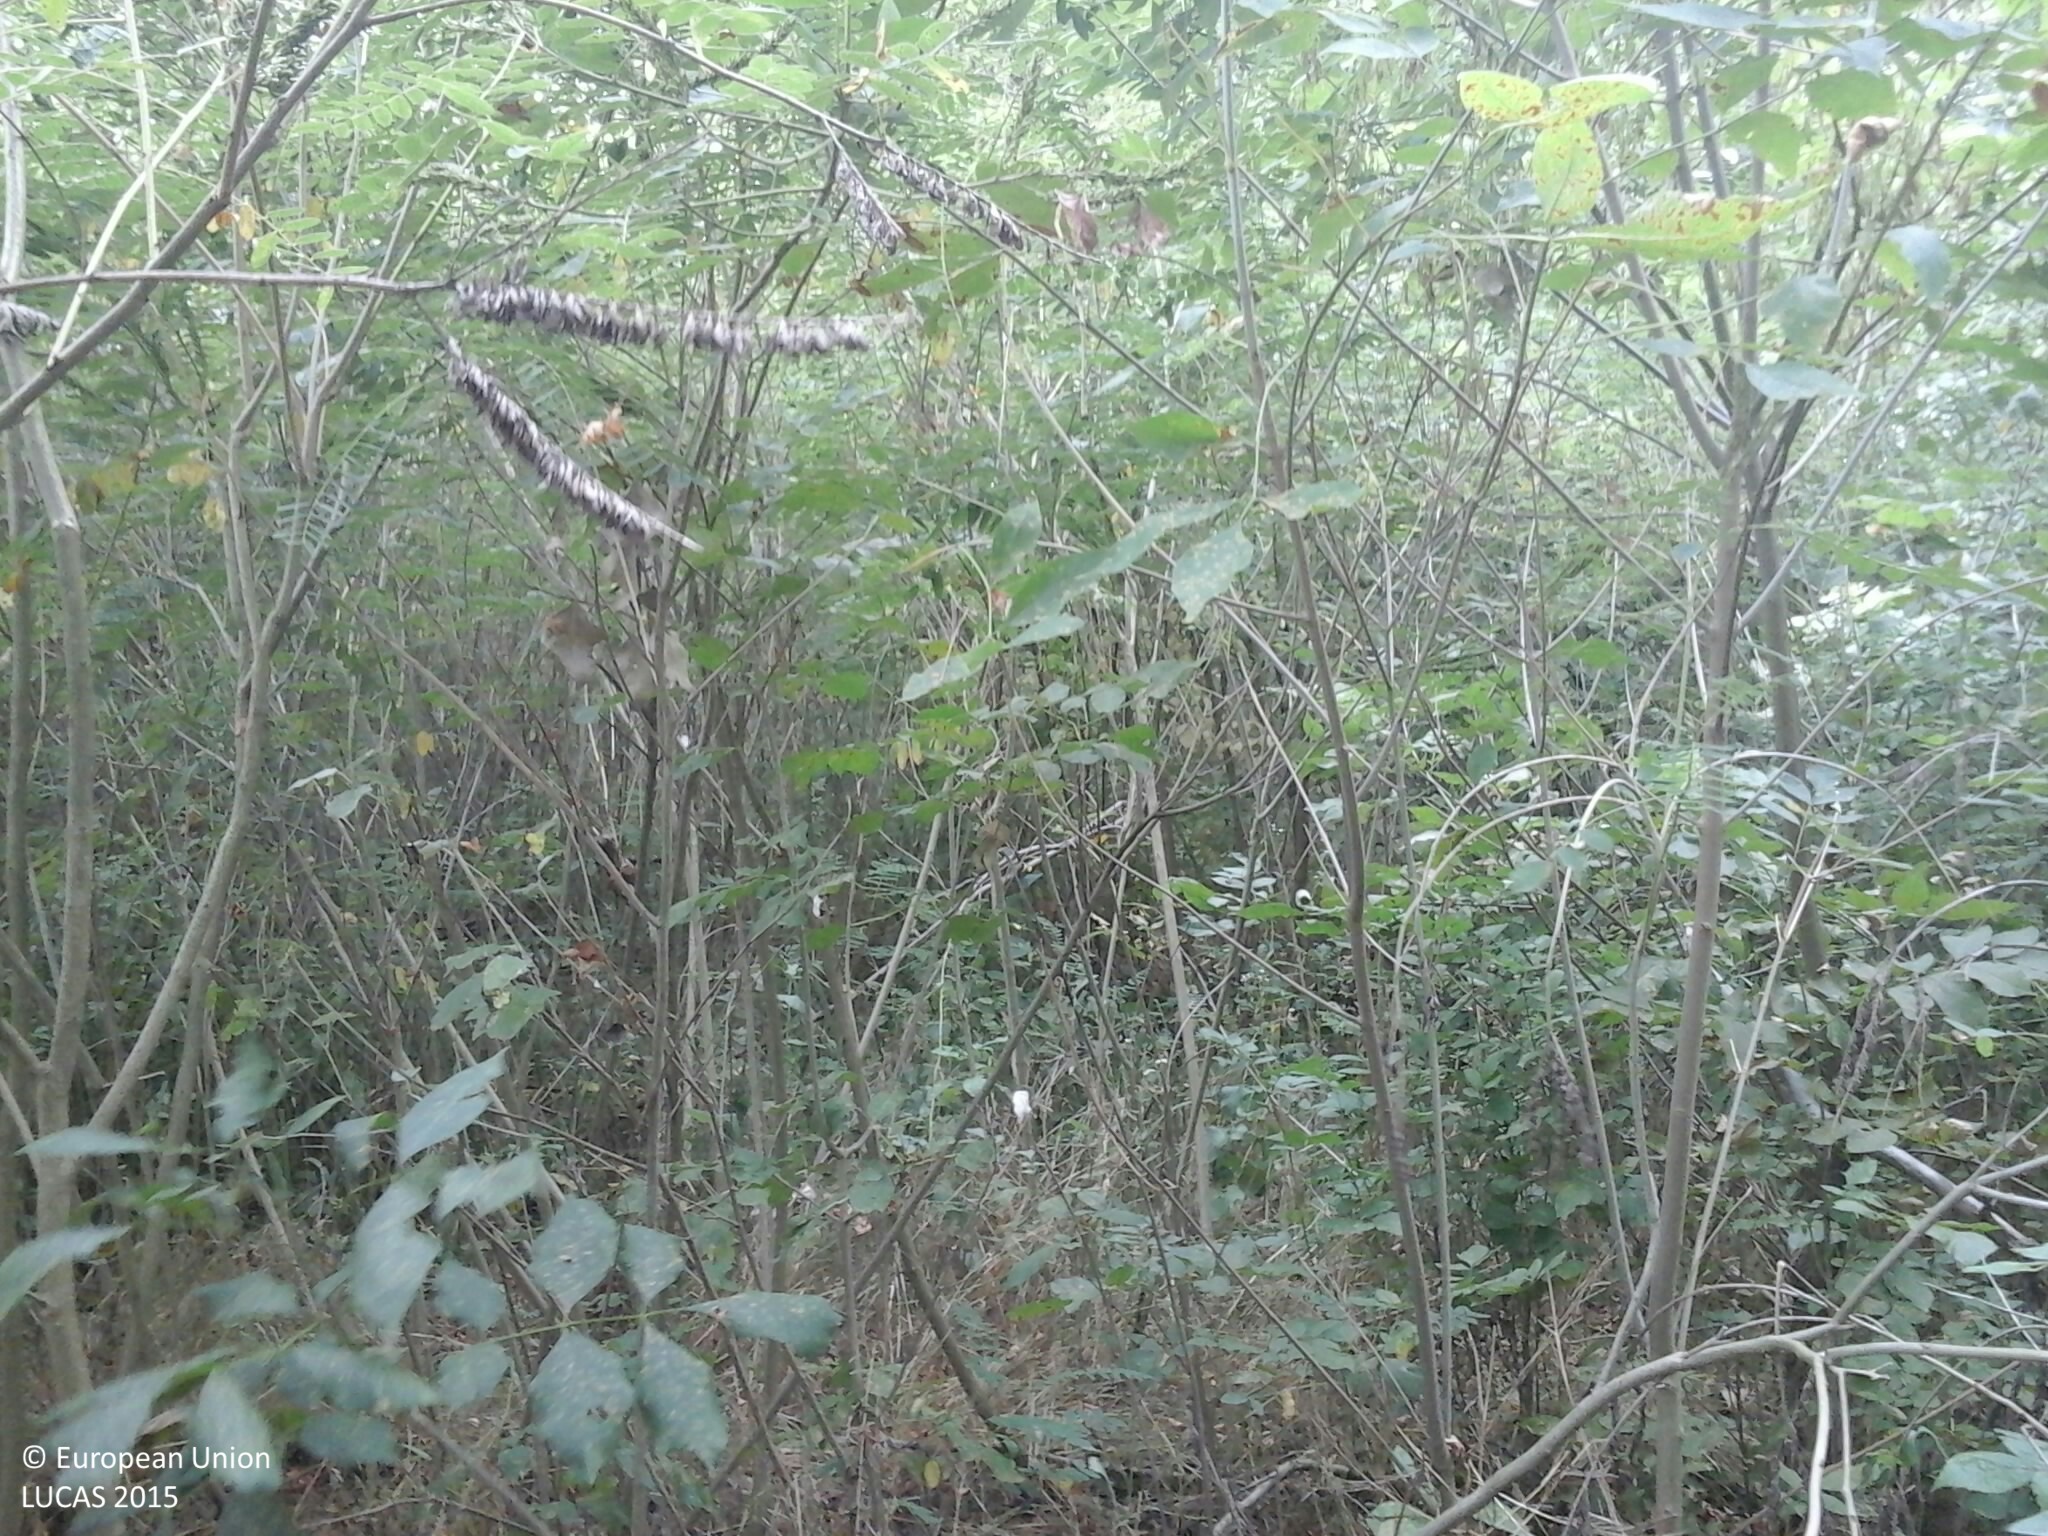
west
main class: Woodland
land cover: Broadleaved woodland
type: floodplain forest
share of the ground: > 75 %
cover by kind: broadleaved forest trees 90 %, shrubs 5 %, herbaceous plants 5 %
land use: Forestry
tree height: < 5 m
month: July
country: HU
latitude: 46.9577
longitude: 20.1302
